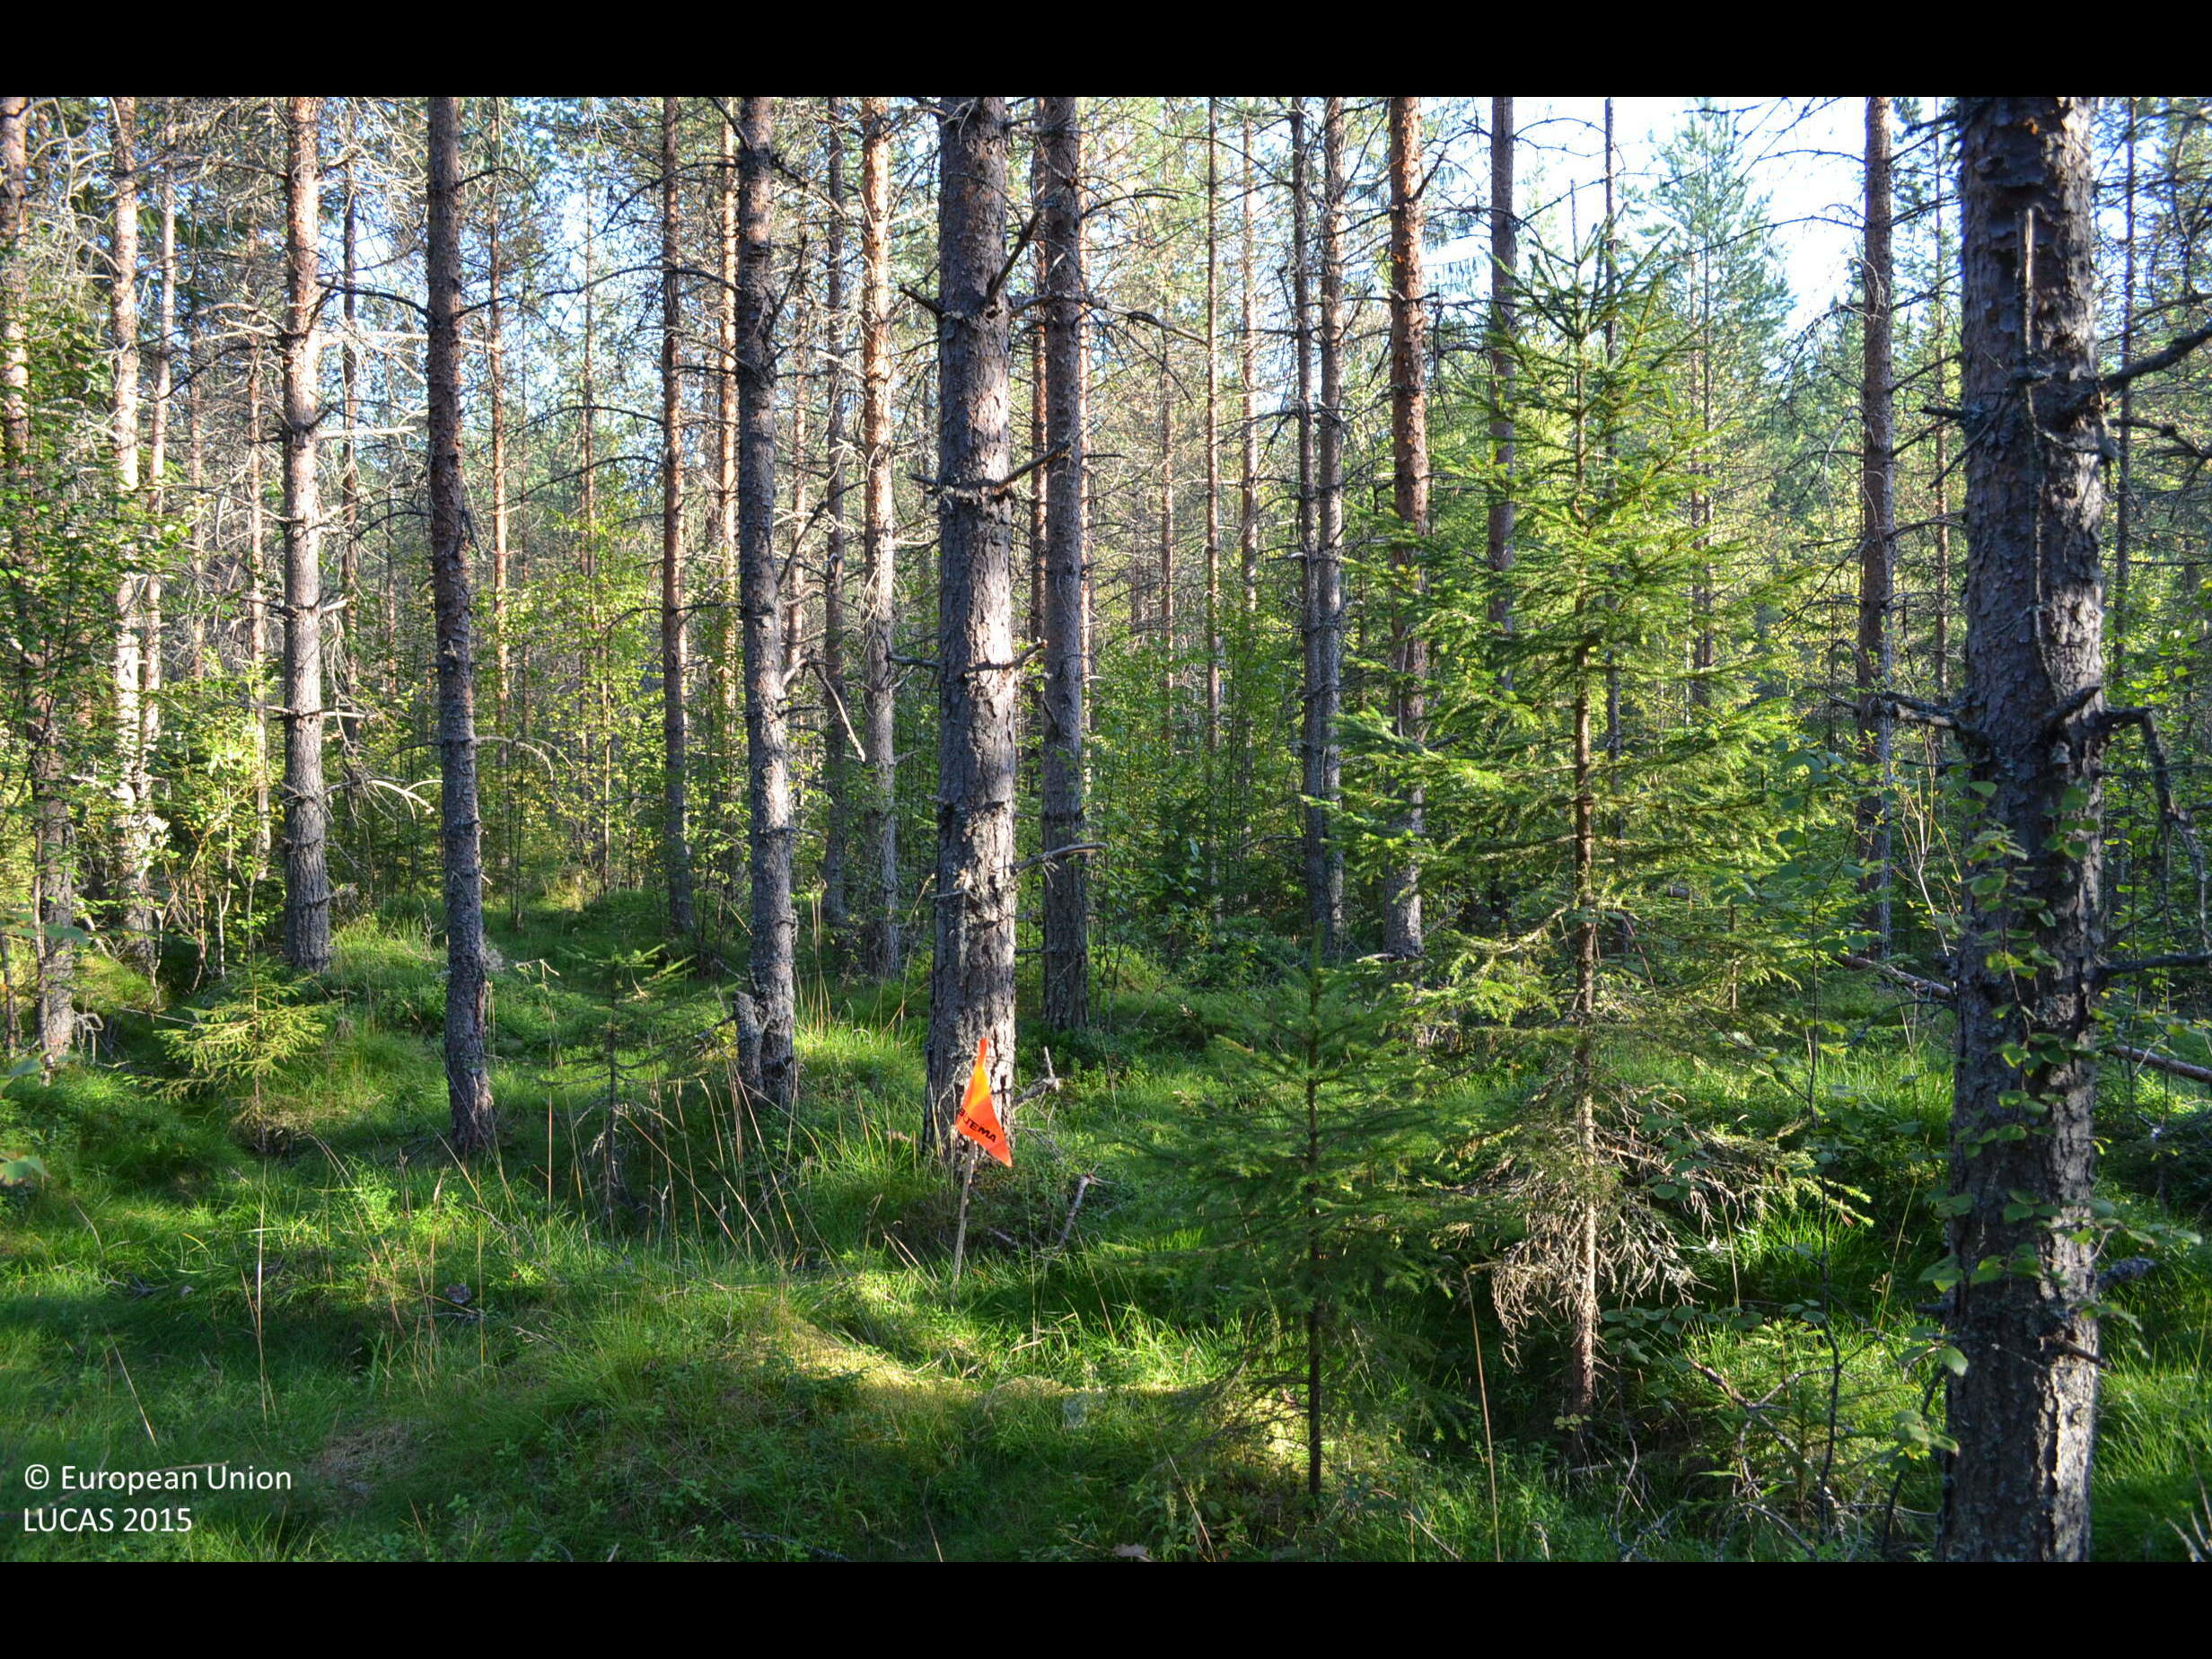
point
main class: Woodland
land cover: Pine dominated coniferous woodland
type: boreal forest
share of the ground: > 75 %
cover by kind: coniferous forest trees 70 %, broadleaved forest trees 10 %, shrubs 10 %, herbaceous plants 10 %
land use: Forestry
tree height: > 5 m
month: August
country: FI
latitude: 62.5316
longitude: 24.4891
